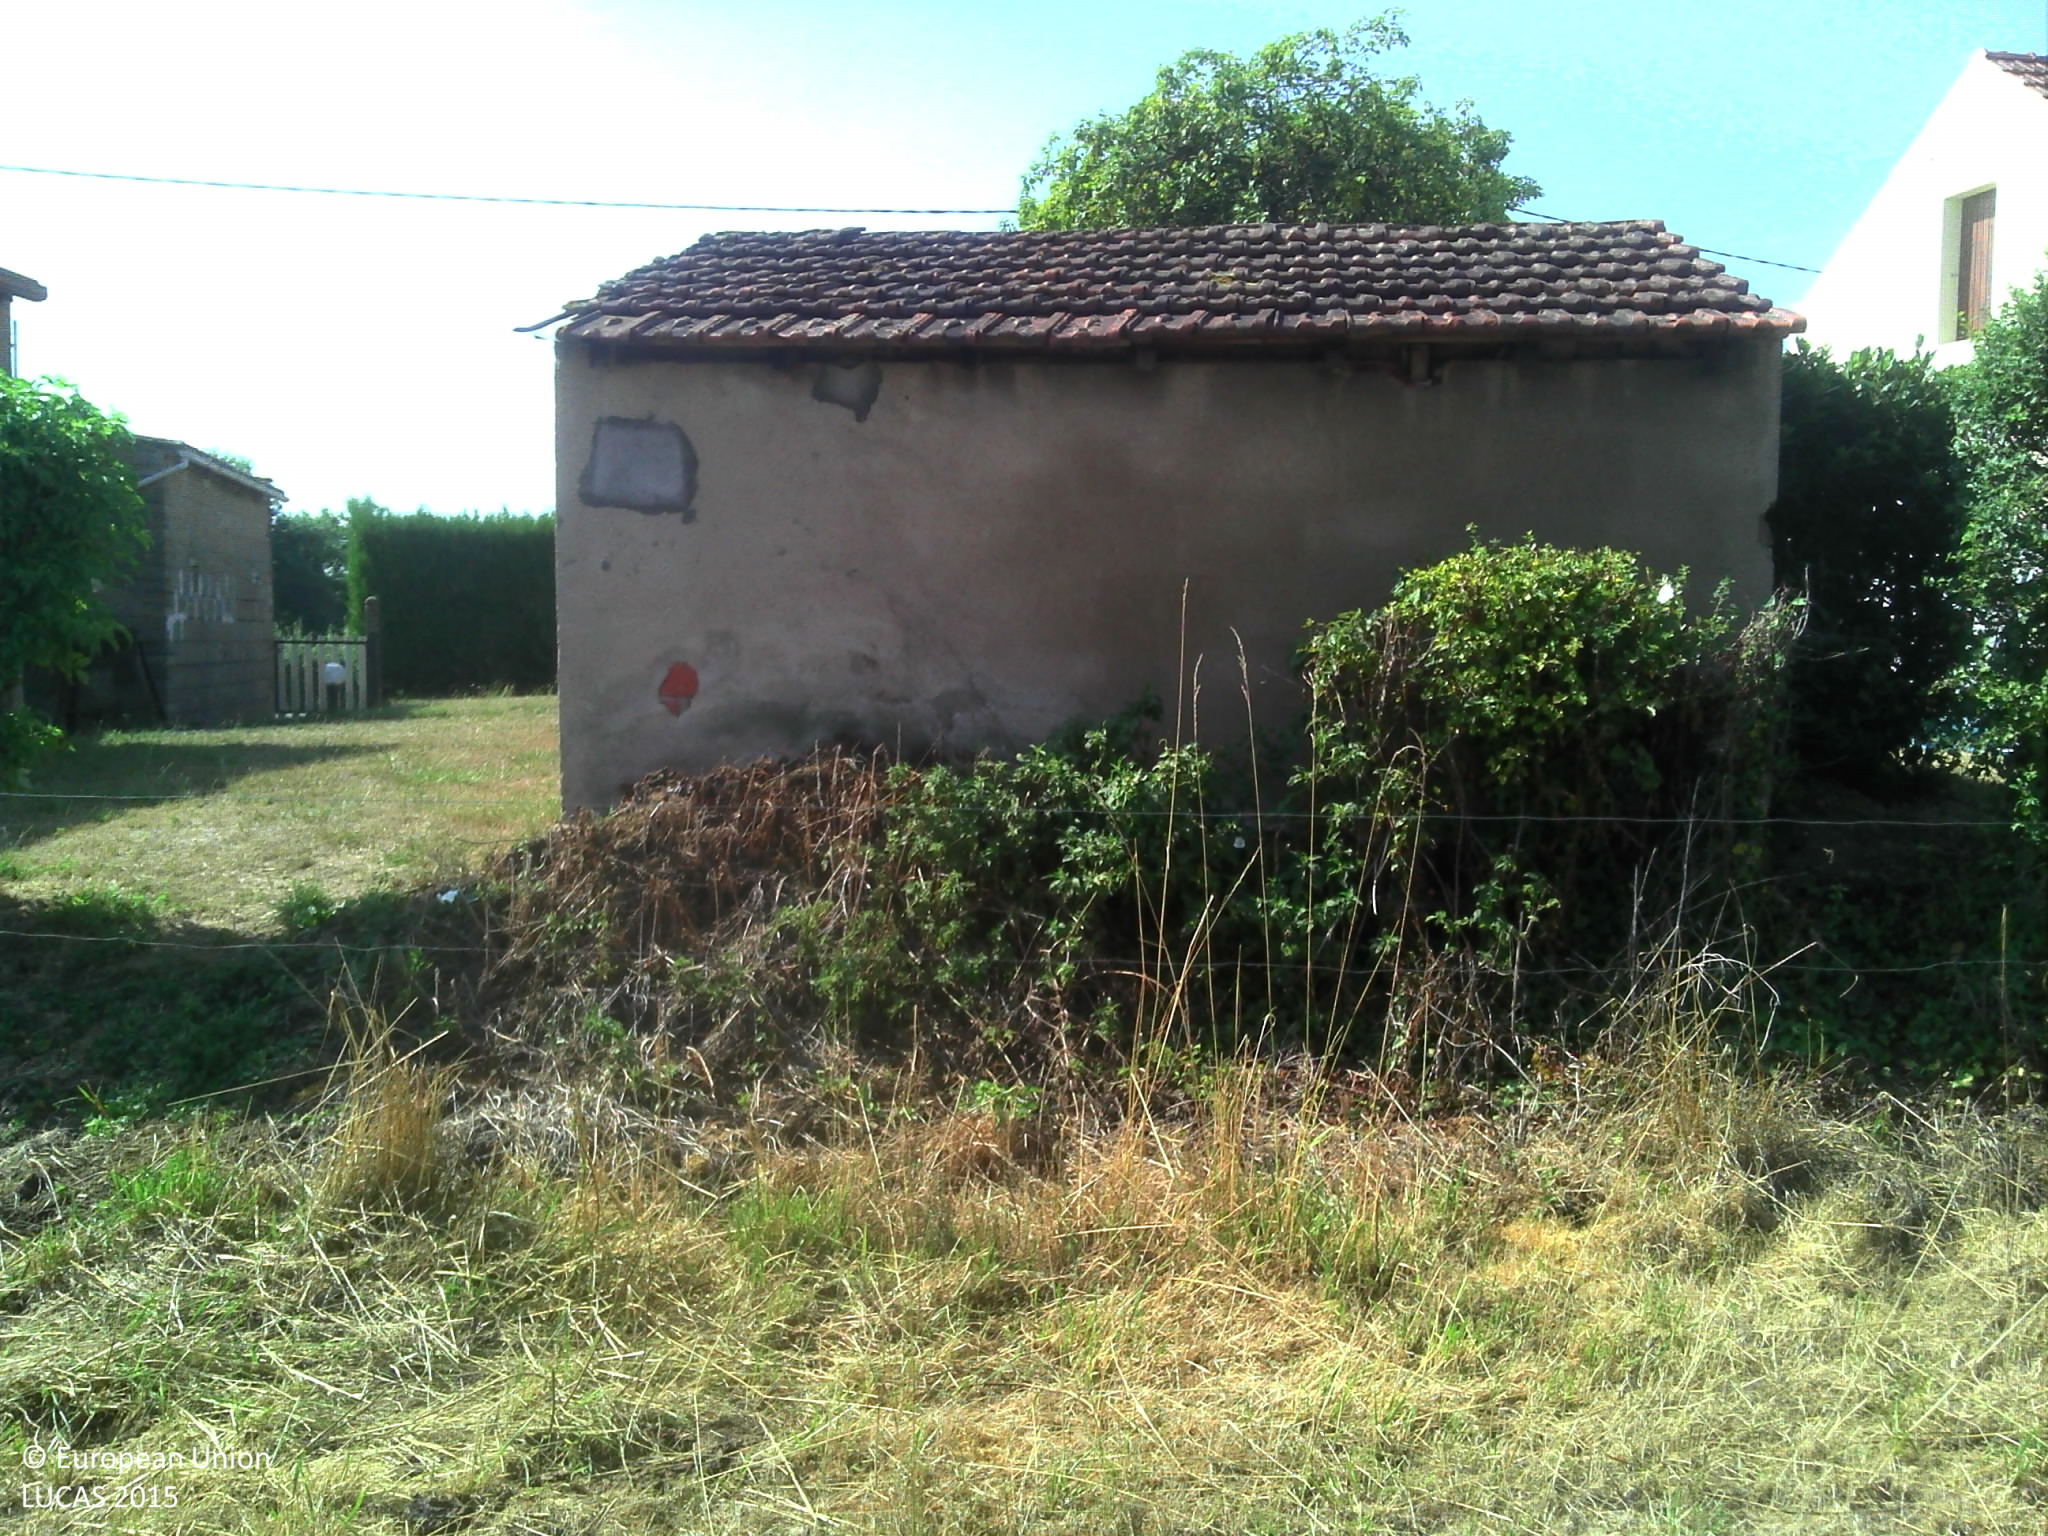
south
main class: Grassland
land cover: Grassland without tree/shrub cover
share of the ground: > 75 %
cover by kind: herbaceous plants 100 %
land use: Agriculture (excluding fallow land and kitchen gardens)
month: August
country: FR
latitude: 46.7094
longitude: 4.3891
